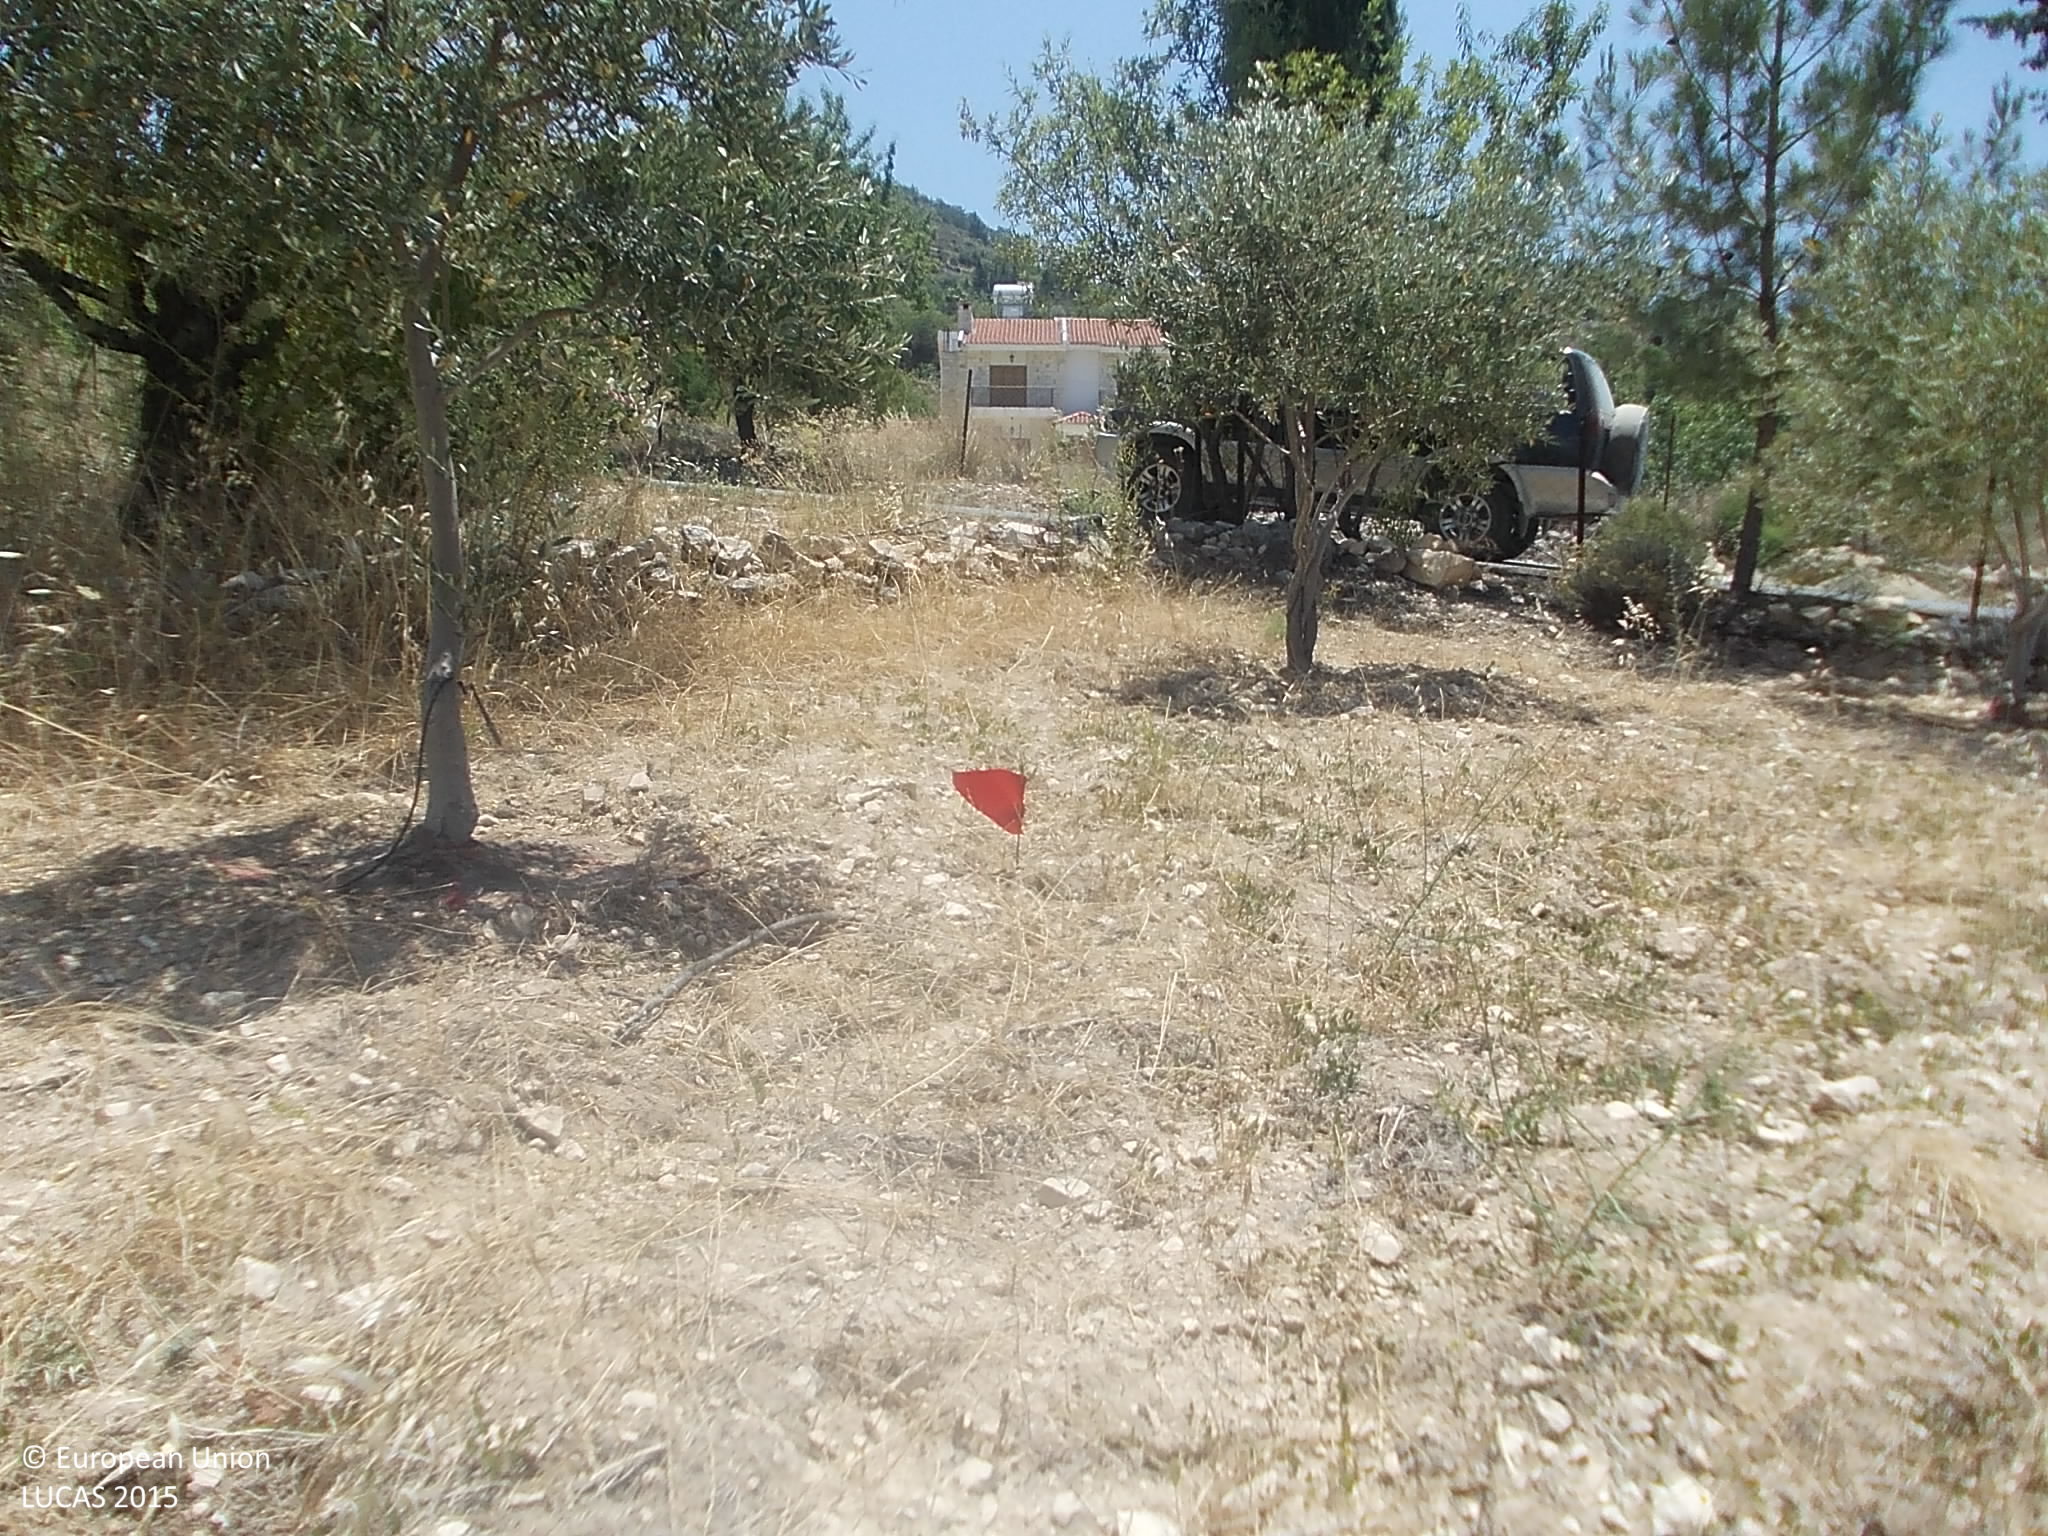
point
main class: Cropland
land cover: Nuts trees
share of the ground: 25 - 50 %
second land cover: Olive groves
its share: < 10 %
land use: Agriculture (excluding fallow land and kitchen gardens)
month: June
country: CY
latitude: 34.8158
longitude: 32.9145
